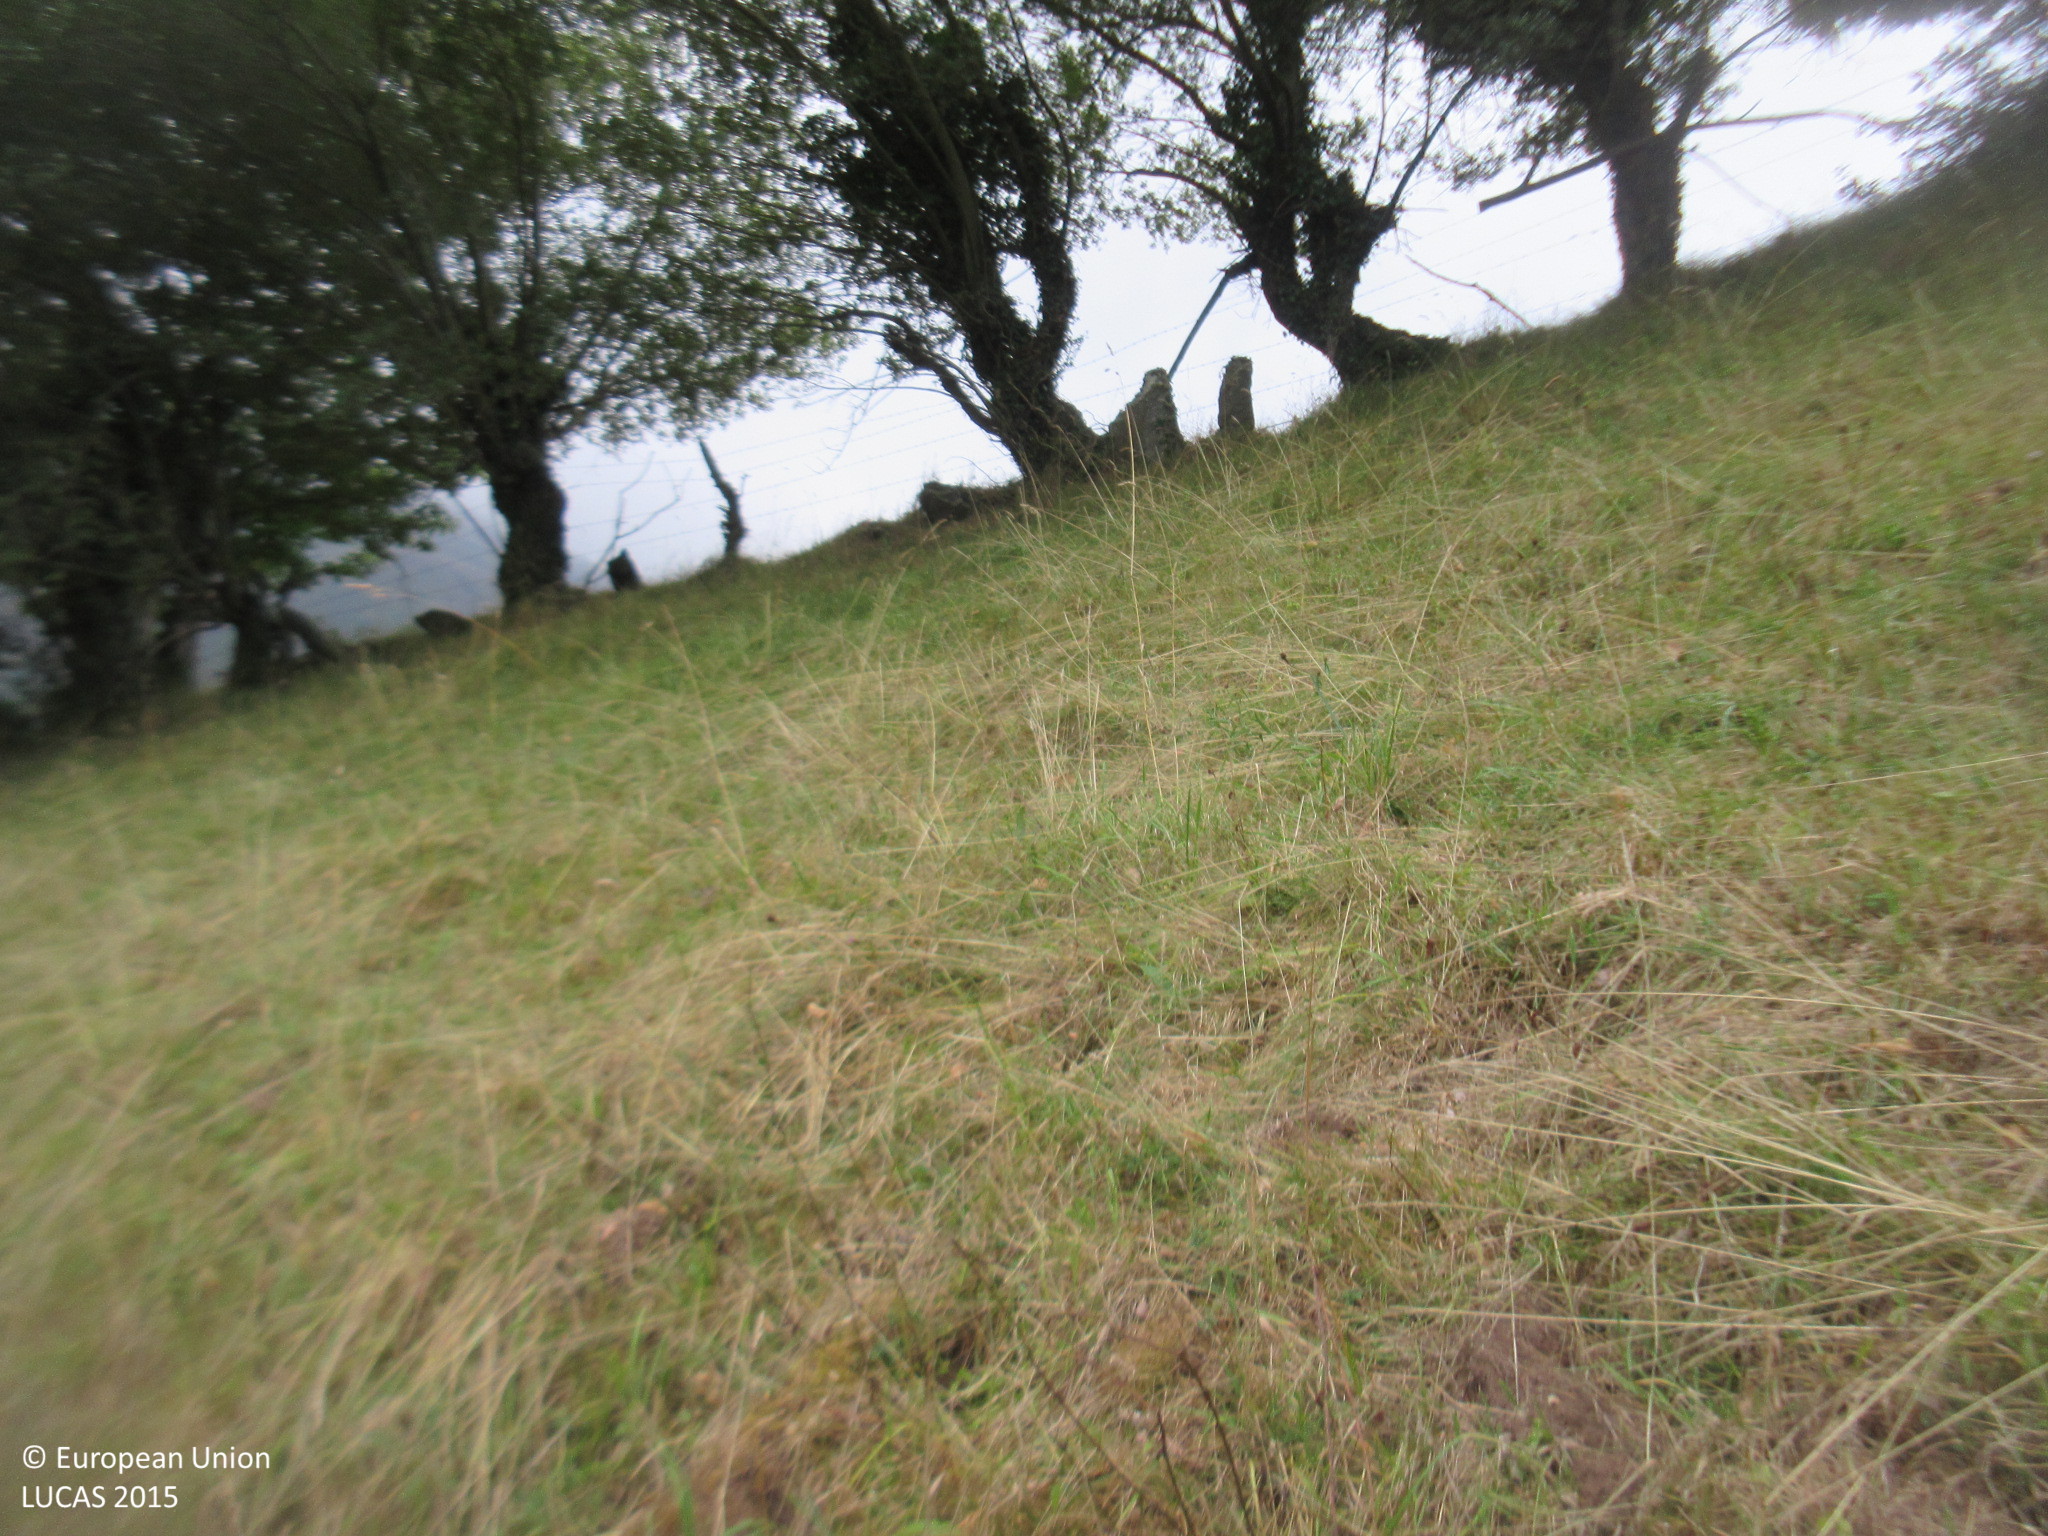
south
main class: Grassland
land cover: Grassland without tree/shrub cover
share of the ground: > 75 %
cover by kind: herbaceous plants 100 %
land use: Agriculture (excluding fallow land and kitchen gardens)
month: August
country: ES
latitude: 43.3610
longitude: -6.6537
